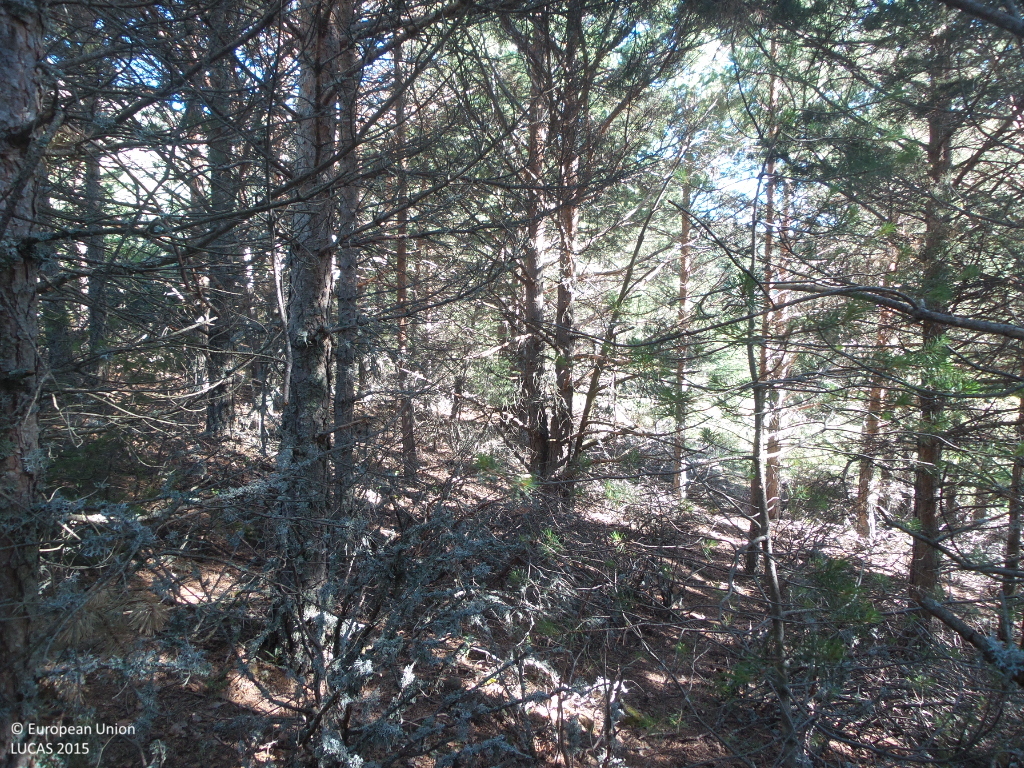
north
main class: Woodland
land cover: Pine dominated coniferous woodland
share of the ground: > 75 %
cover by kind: coniferous forest trees 80 %, shrubs 20 %
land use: Semi-natural and natural areas not in use
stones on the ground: < 10 %
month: June
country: ES
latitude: 41.1578
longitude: -3.1119
